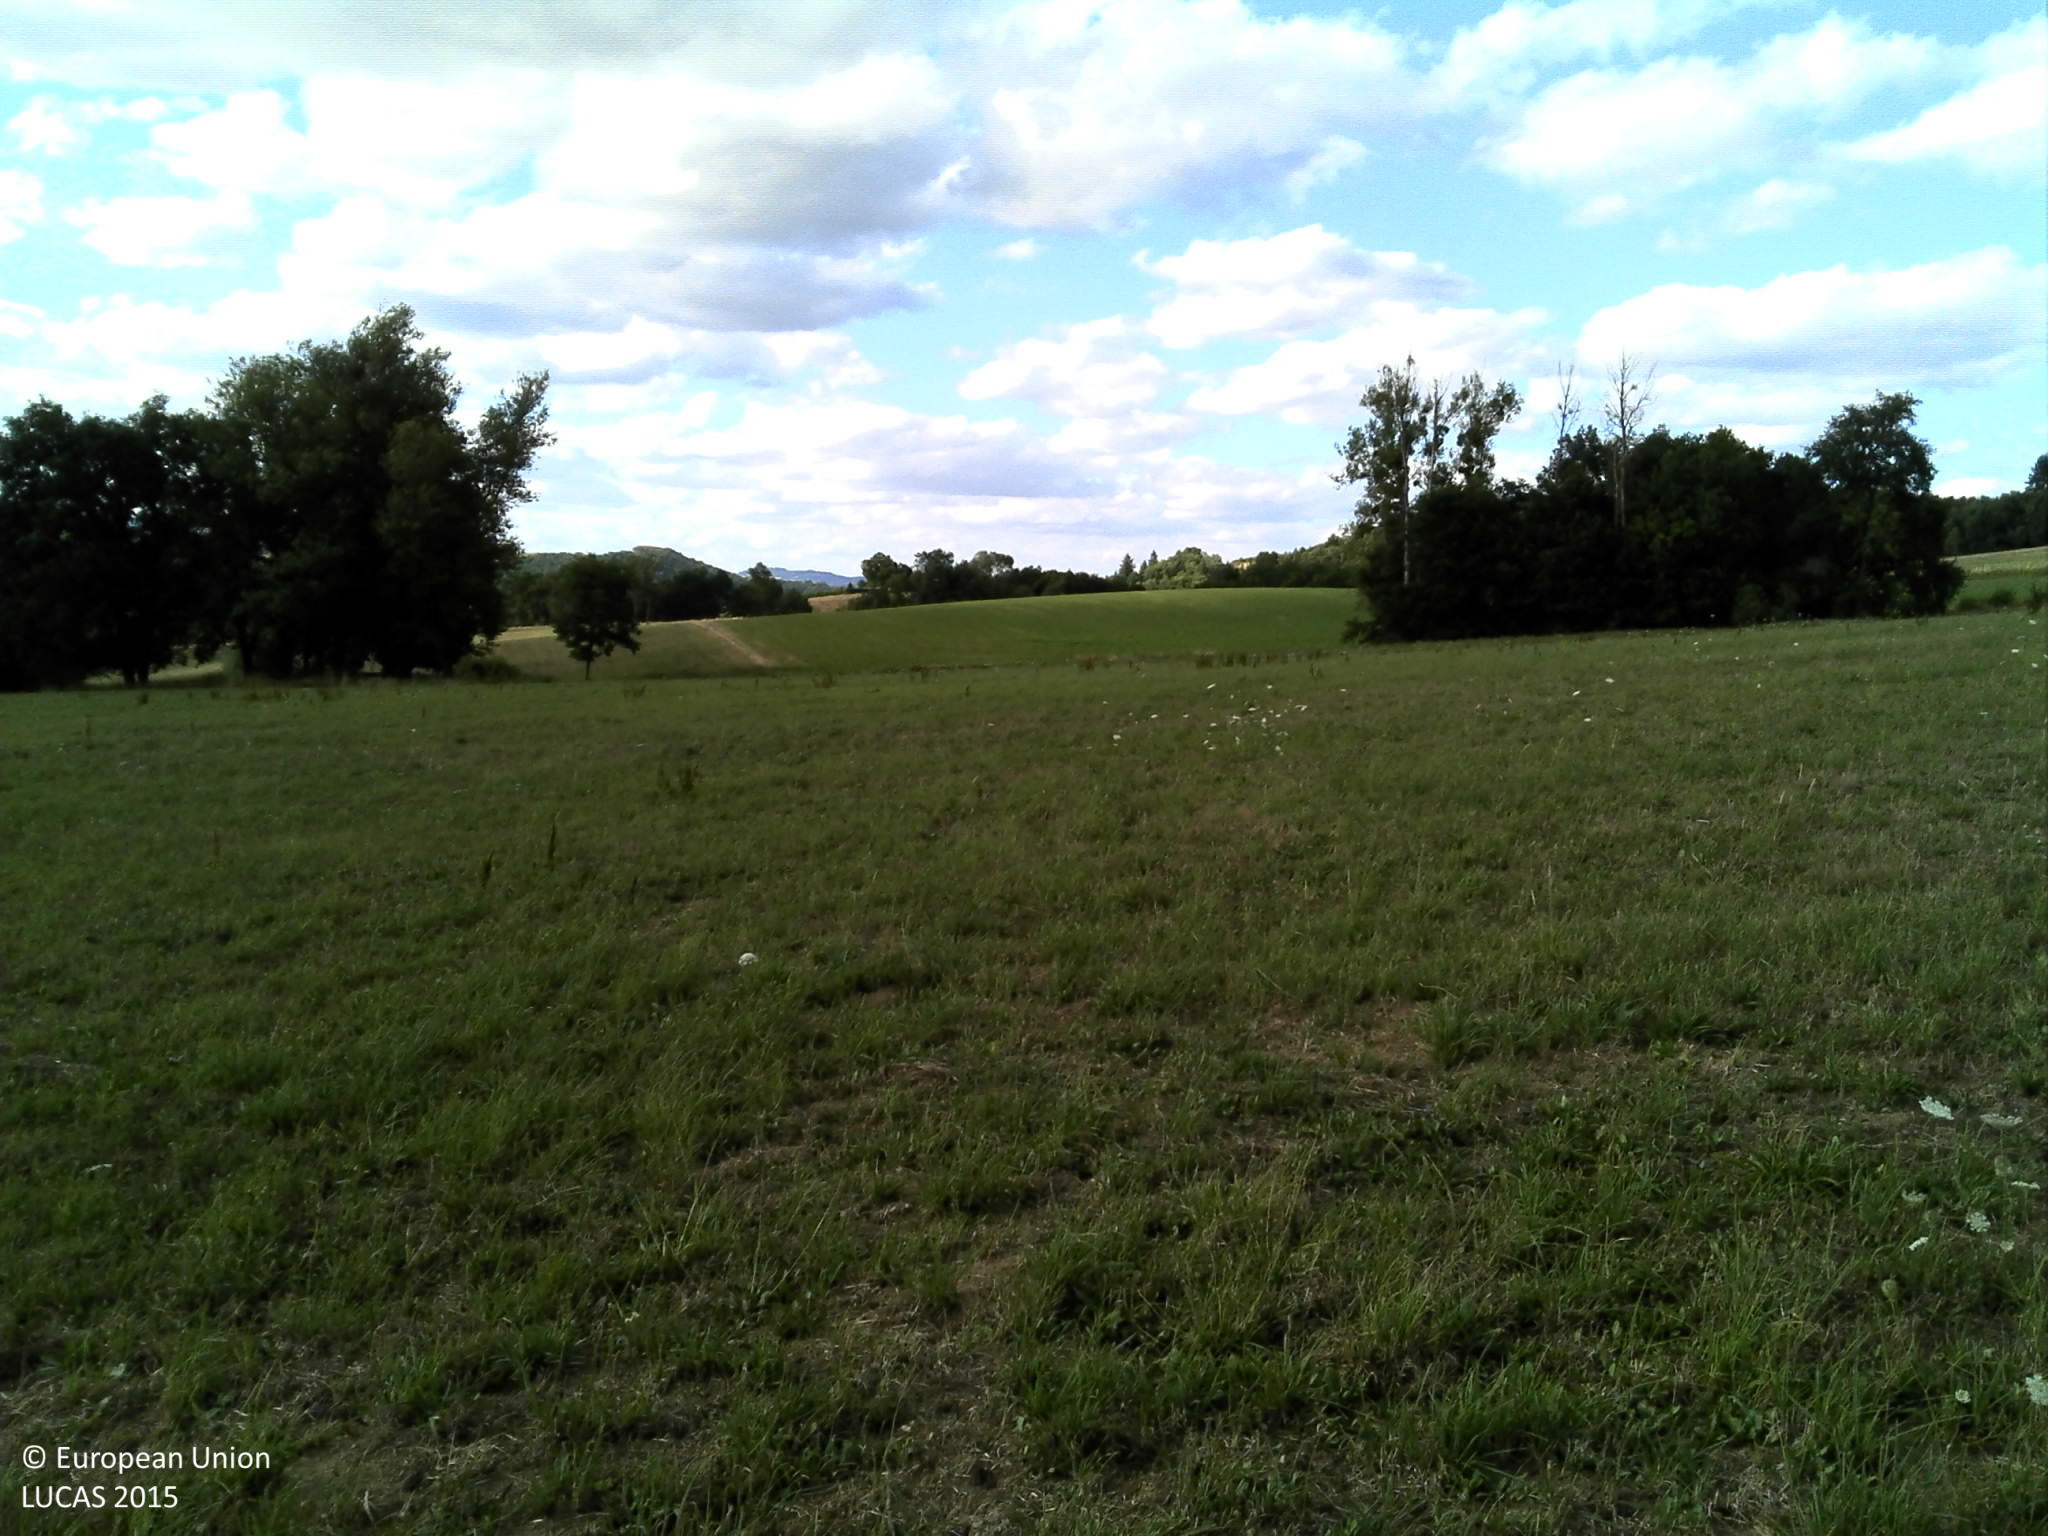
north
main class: Grassland
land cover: Grassland without tree/shrub cover
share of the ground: > 75 %
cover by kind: herbaceous plants 90 %, shrubs 5 %, lichens and mosses 5 %
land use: Agriculture (excluding fallow land and kitchen gardens)
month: July
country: FR
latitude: 45.5121
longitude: 3.3580
